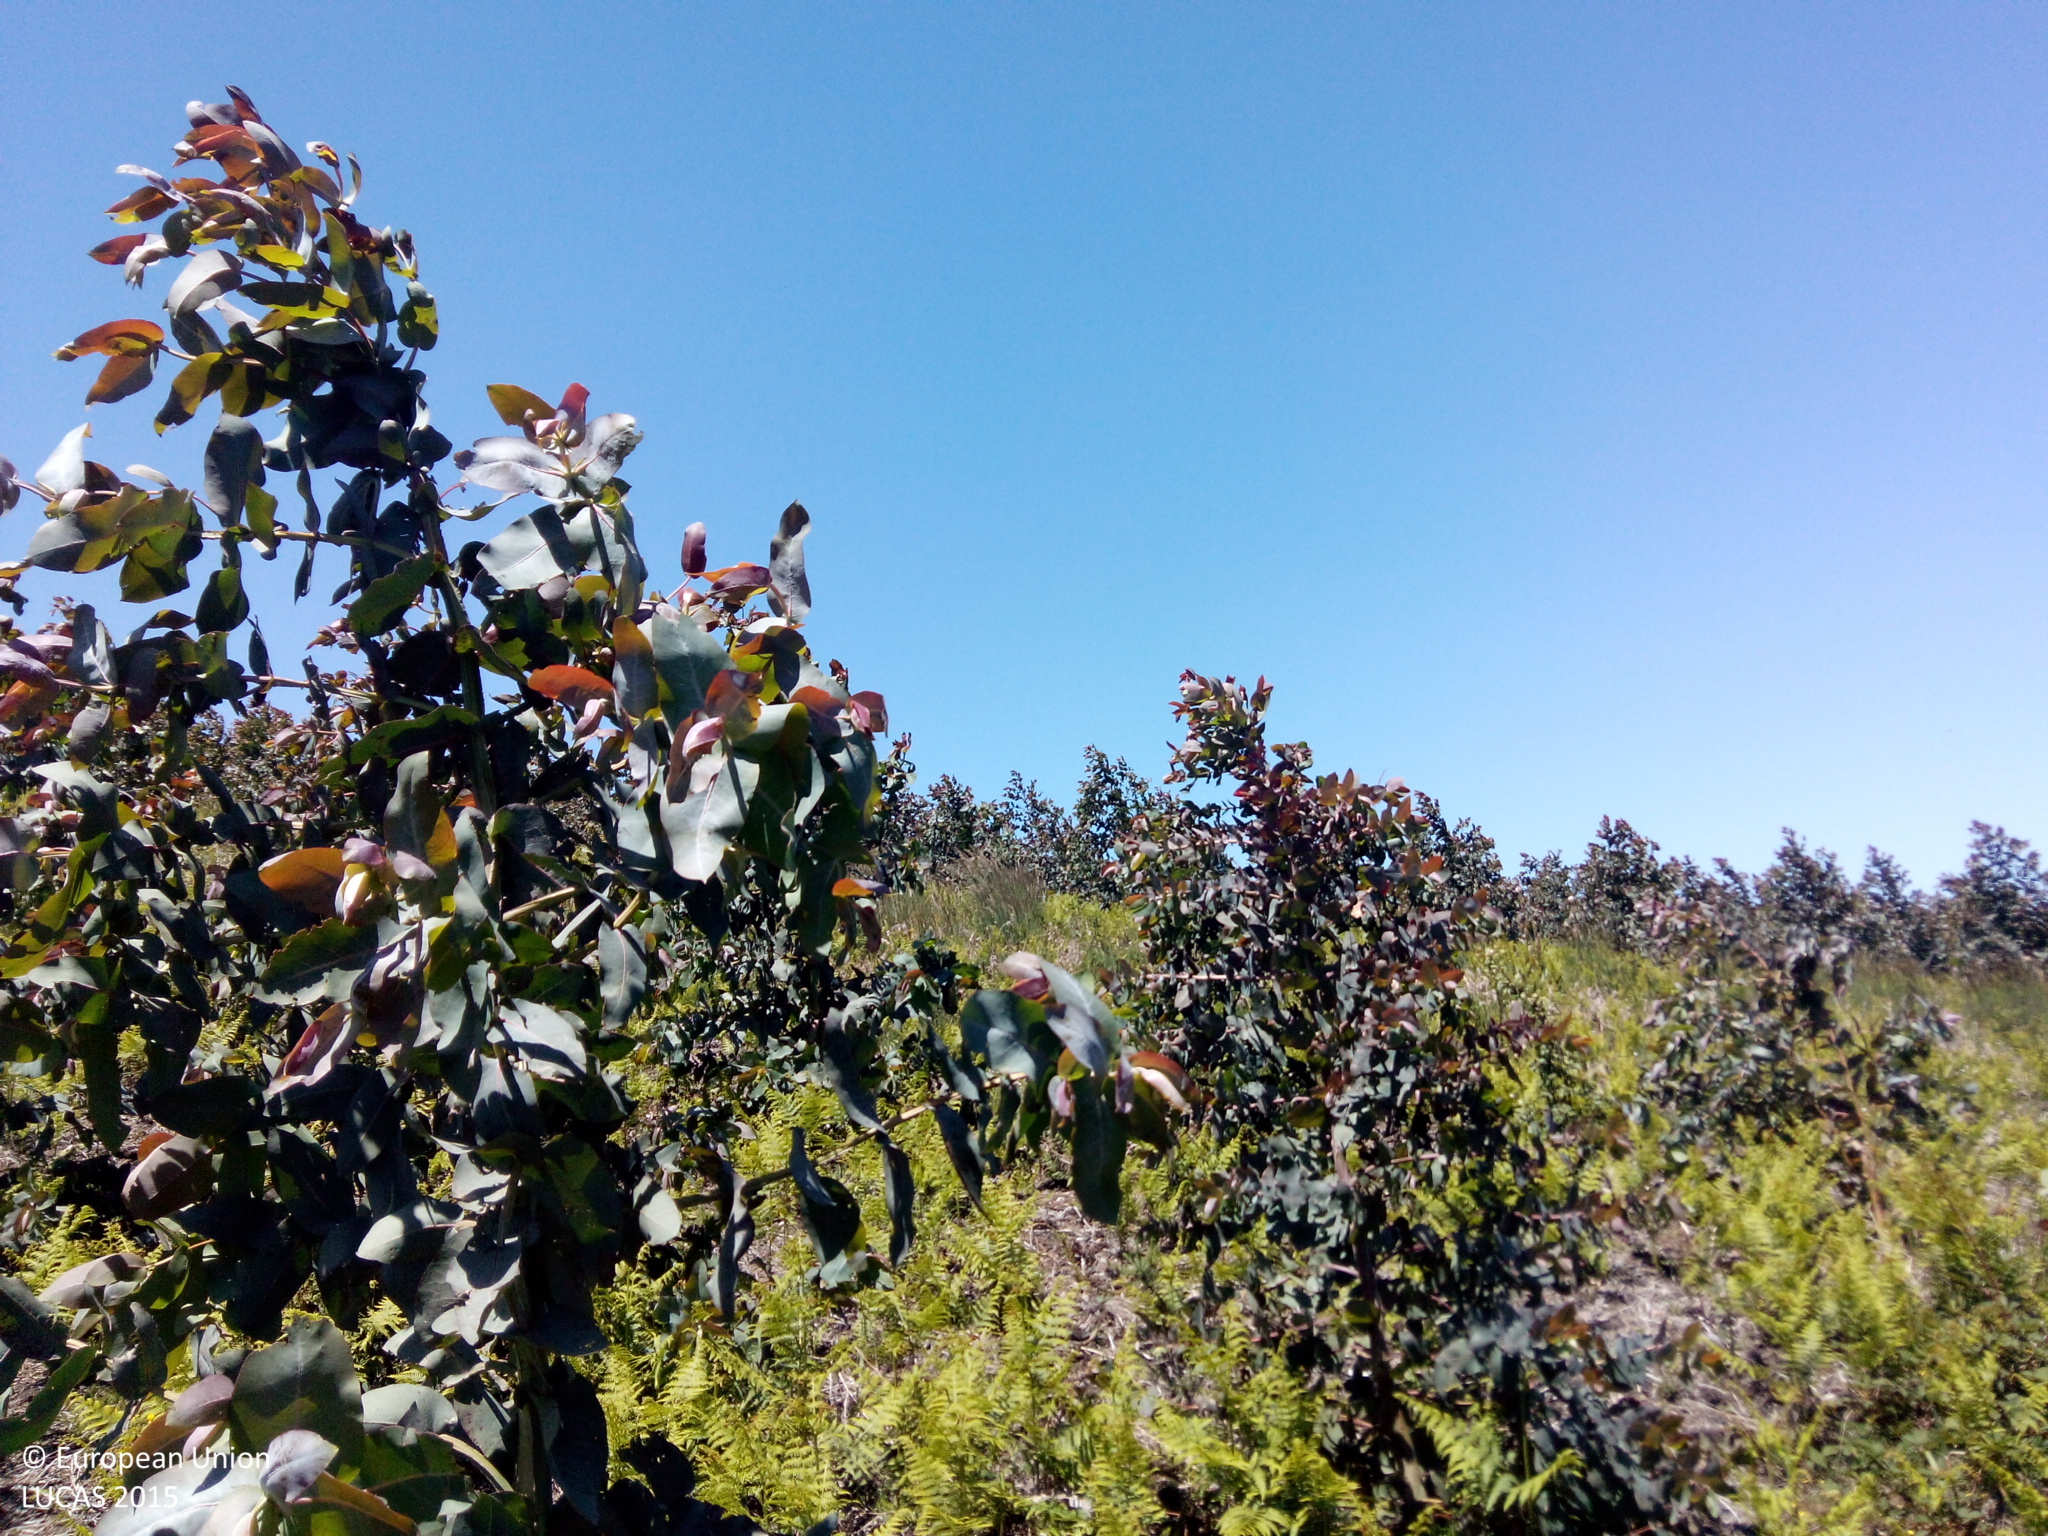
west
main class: Woodland
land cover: Broadleaved woodland
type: exotic forest
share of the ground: > 75 %
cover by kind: broadleaved forest trees 75 %, herbaceous plants 15 %, shrubs 10 %
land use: Forestry
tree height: < 5 m
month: May
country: ES
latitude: 42.6146
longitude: -8.3949
